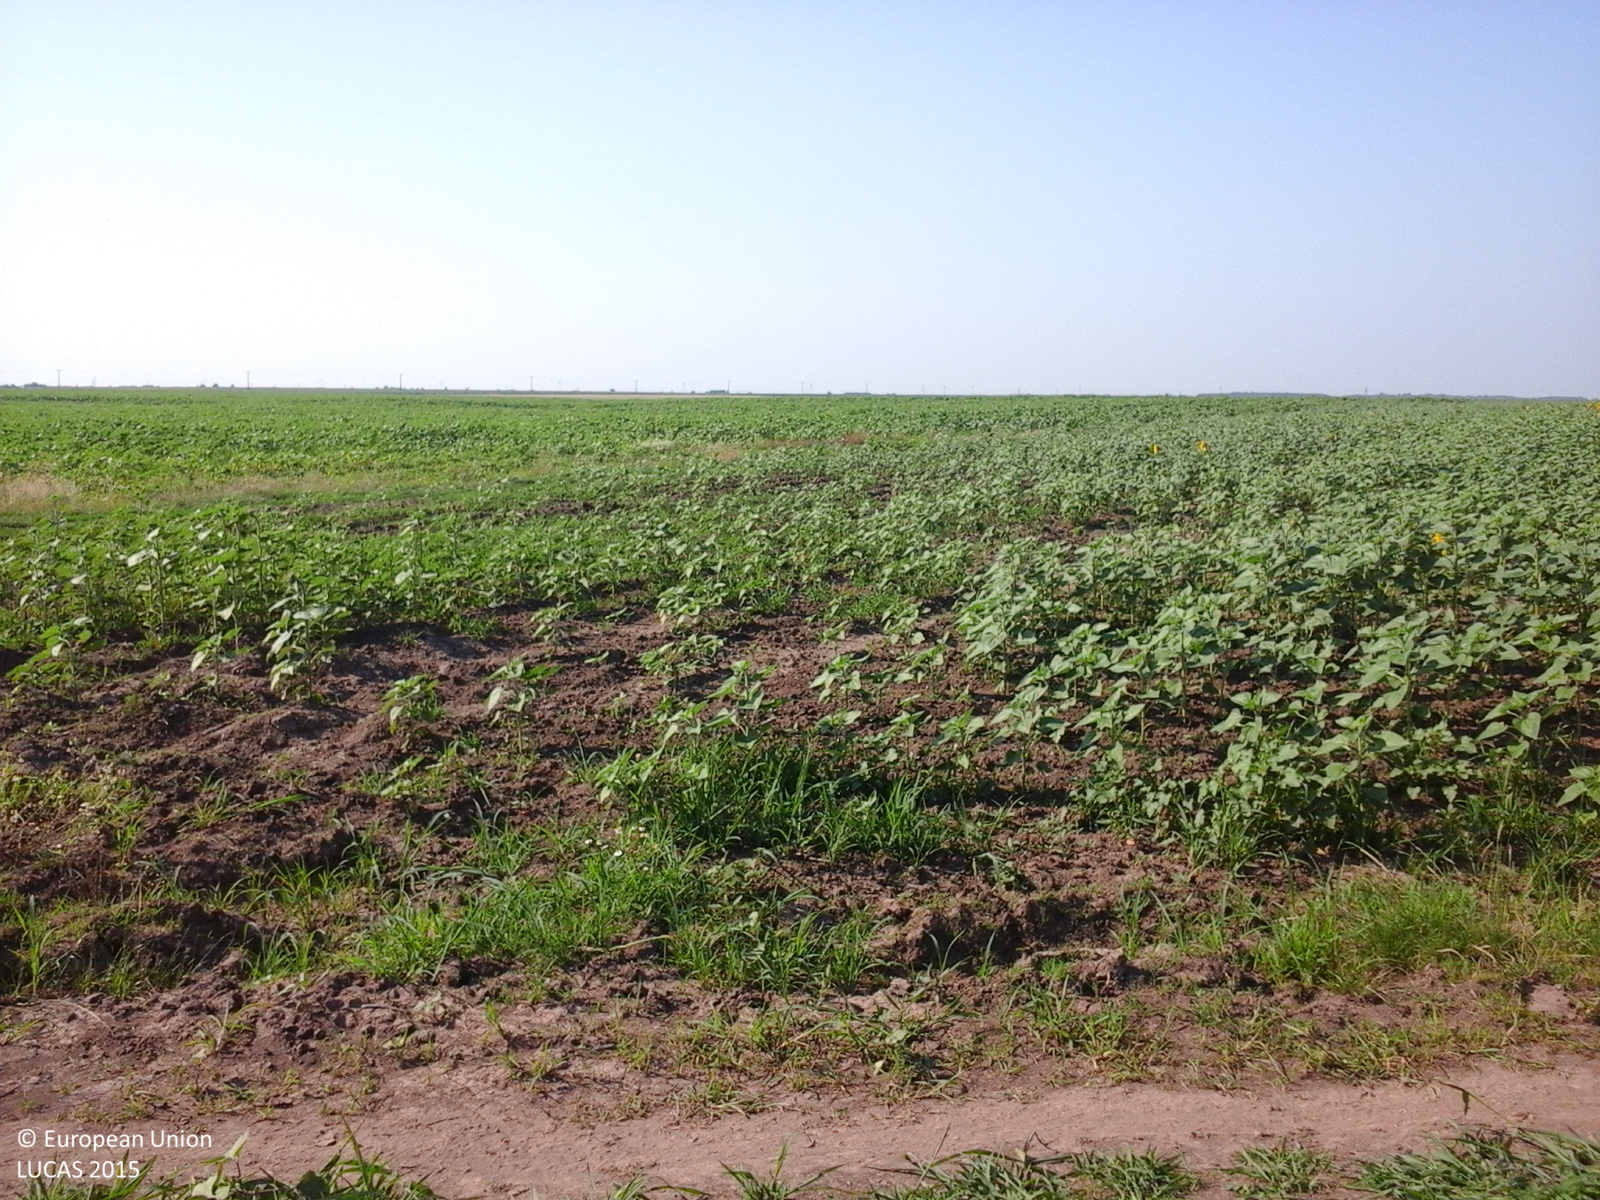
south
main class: Cropland
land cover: Maize
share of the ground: > 75 %
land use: Agriculture (excluding fallow land and kitchen gardens)
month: July
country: RO
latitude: 44.6492
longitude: 24.8446
